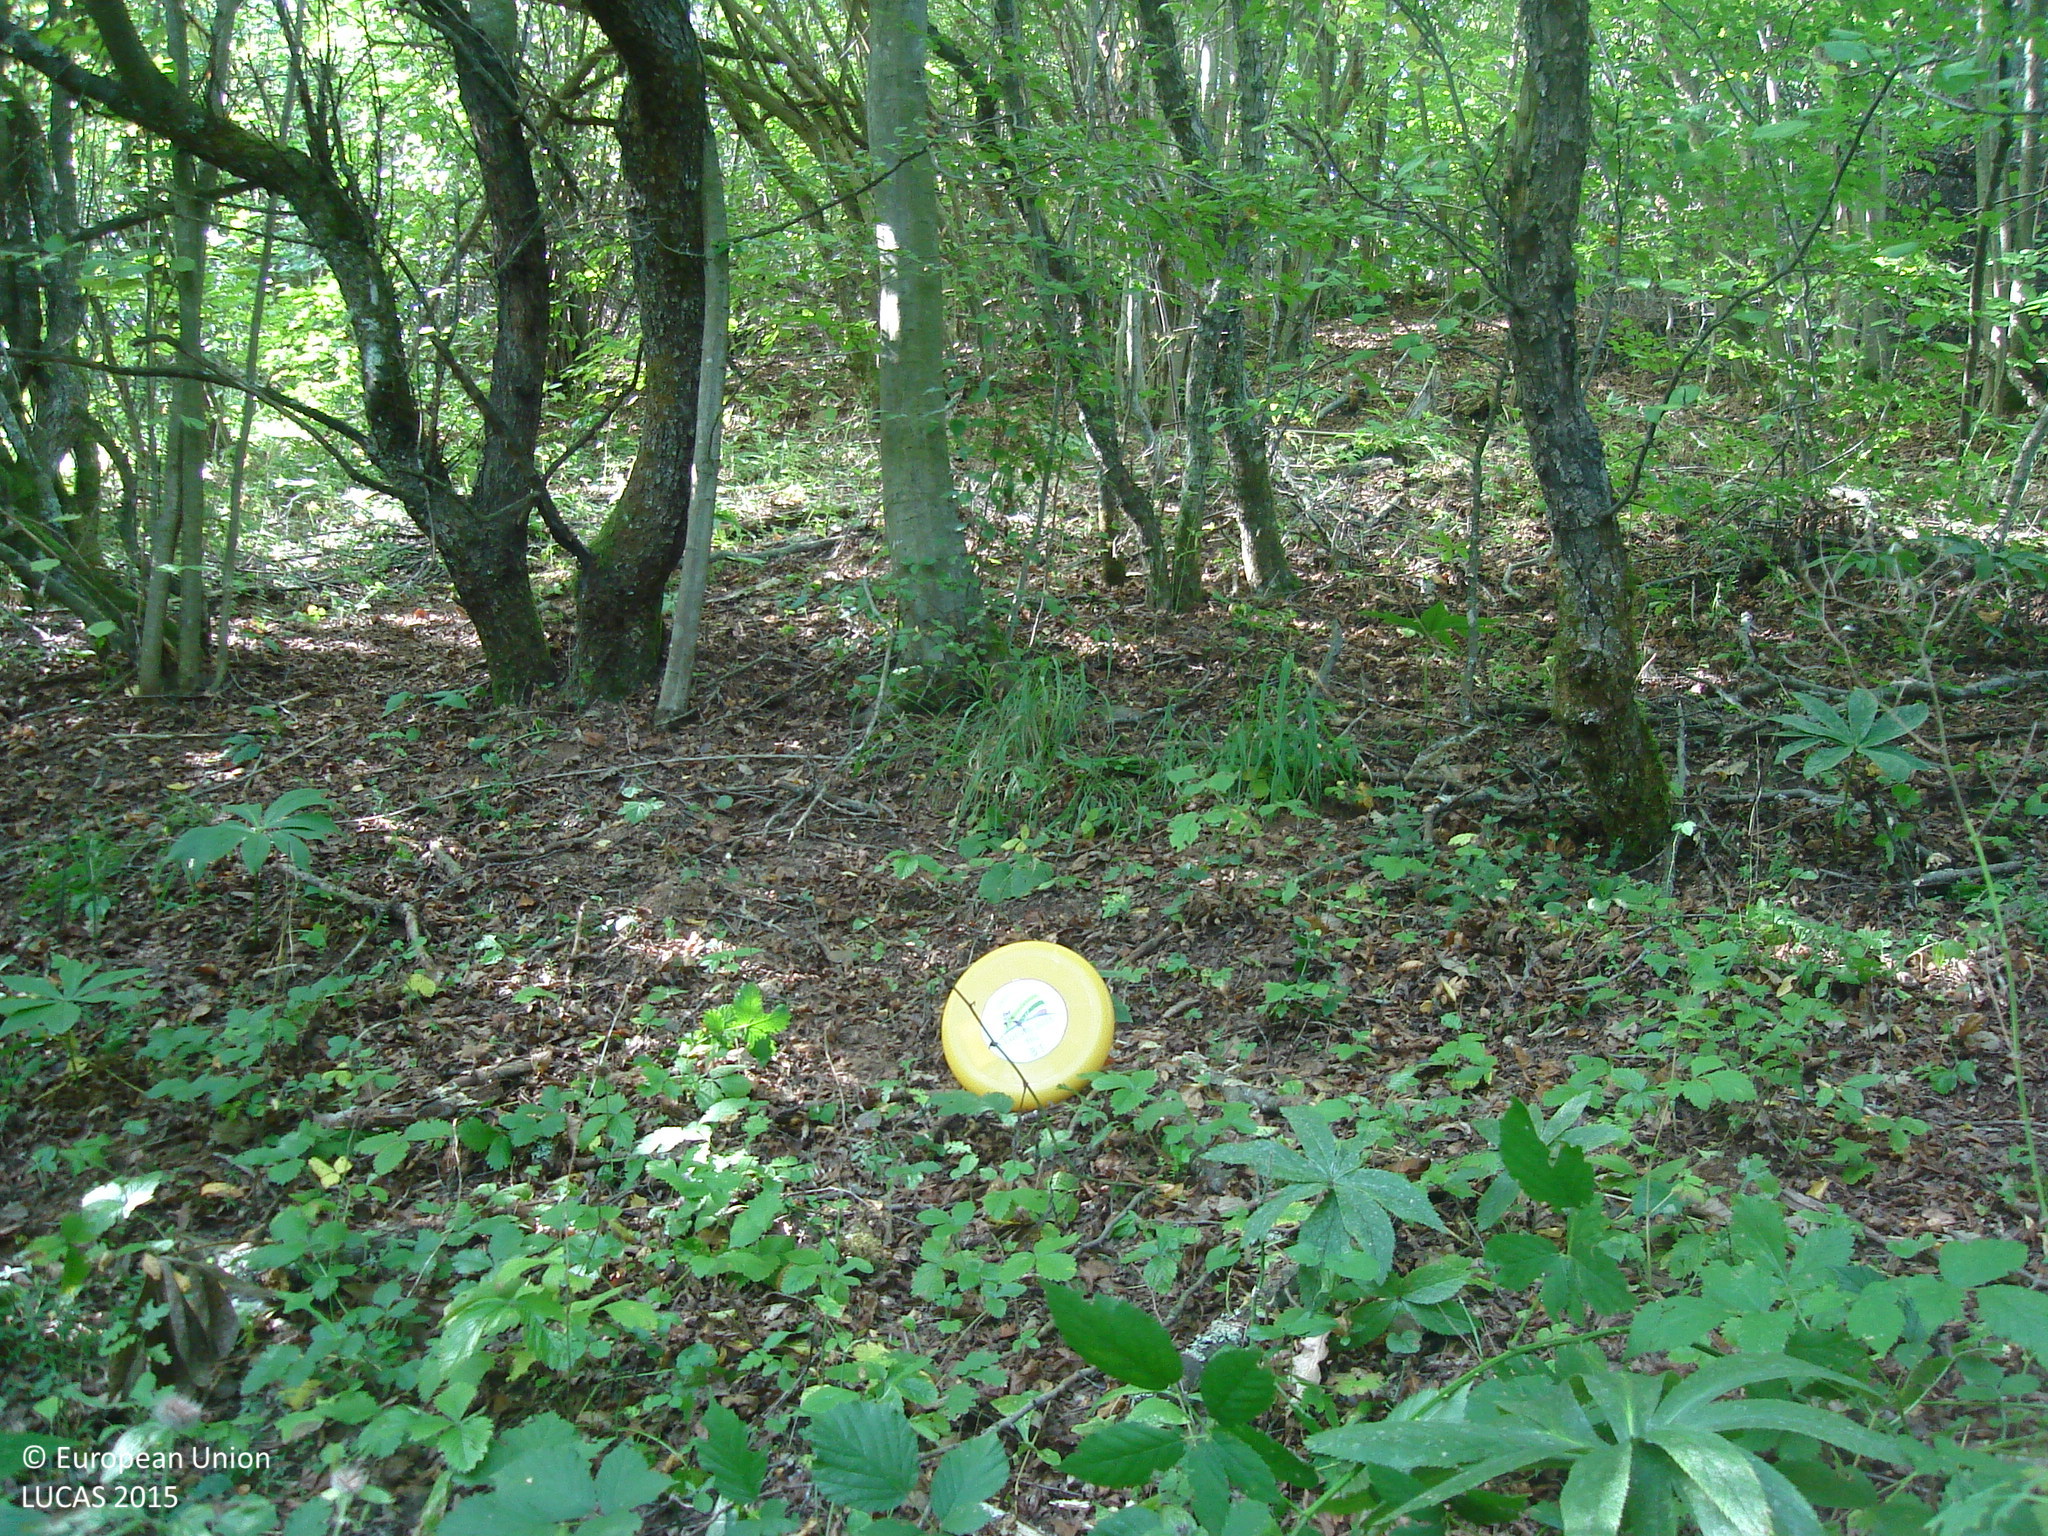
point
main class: Woodland
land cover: Broadleaved woodland
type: thermophilous deciduous forest
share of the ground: > 75 %
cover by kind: broadleaved forest trees 95 %, herbaceous plants 5 %
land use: Forestry
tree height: > 5 m
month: September
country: BG
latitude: 42.9840
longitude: 23.1194
